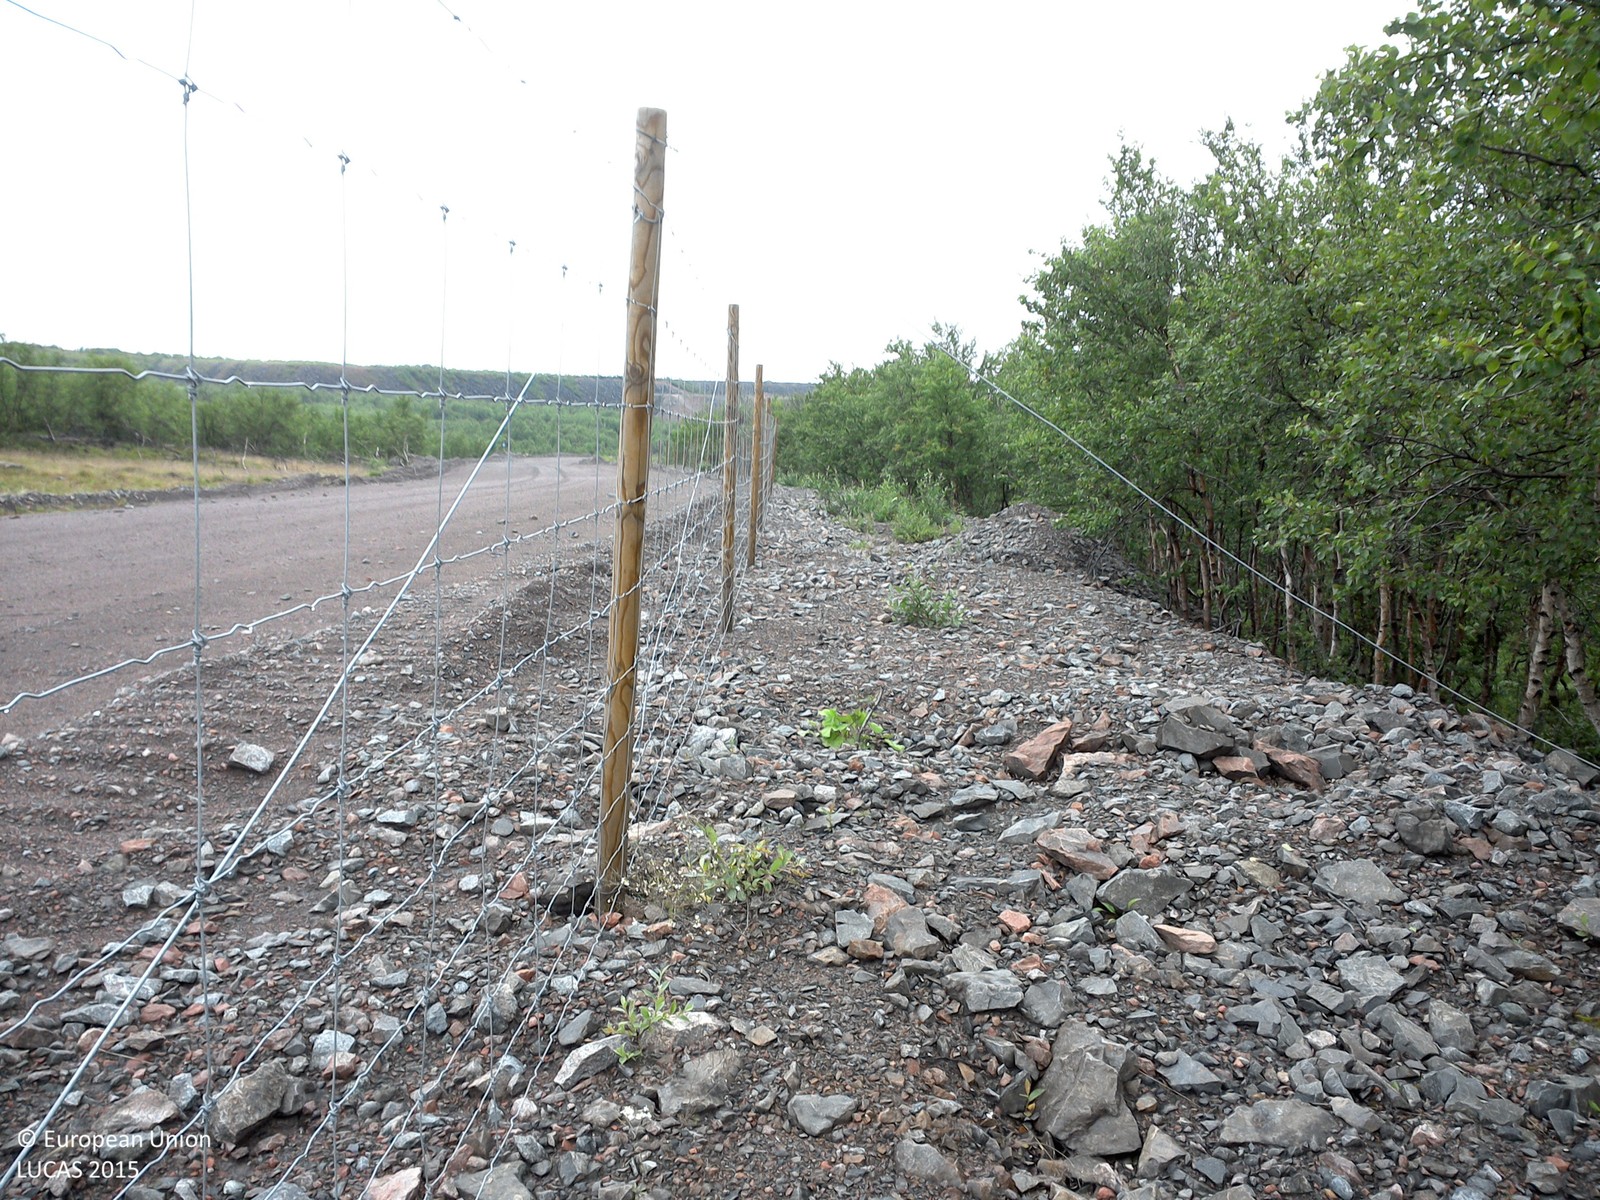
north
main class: Woodland
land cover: Broadleaved woodland
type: boreal forest
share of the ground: 25 - 50 %
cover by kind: shrubs 60 %, broadleaved forest trees 40 %
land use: Mining and quarrying
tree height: < 5 m
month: August
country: SE
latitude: 67.8138
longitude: 20.2147
